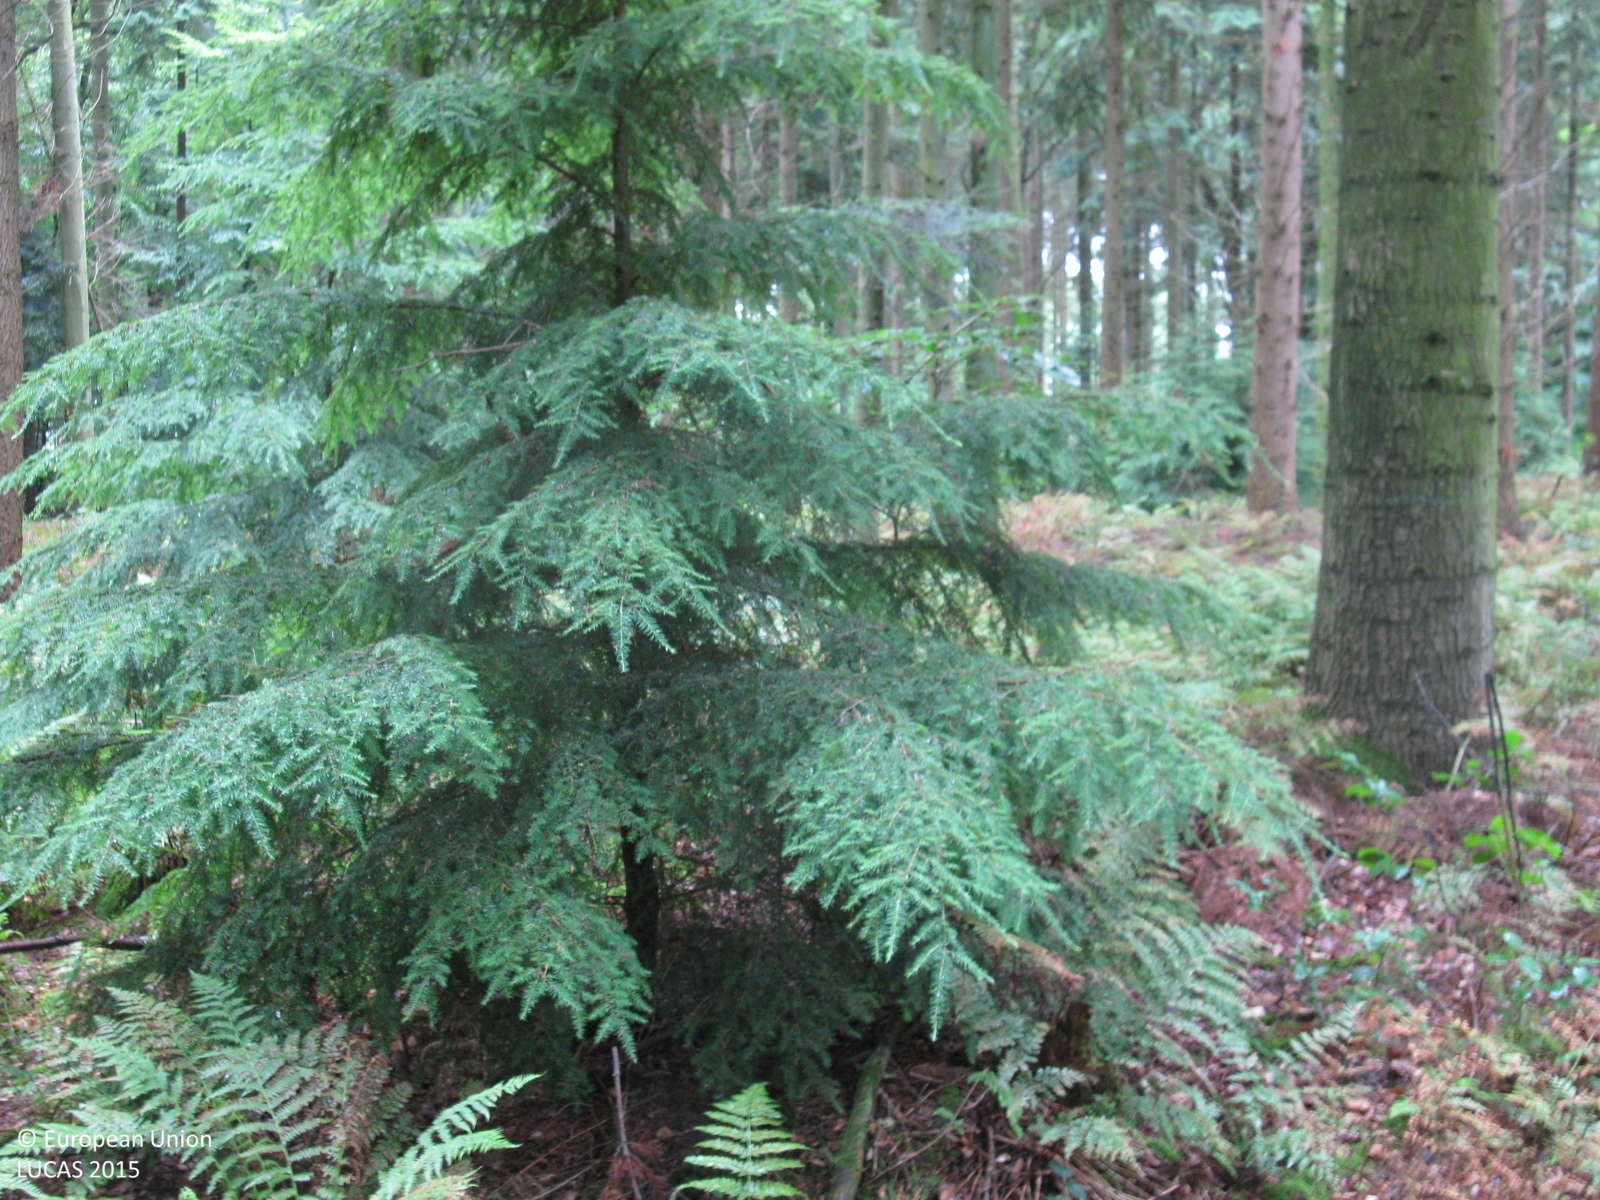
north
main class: Woodland
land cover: Other coniferous woodland
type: hemiboreal forest and nemoral coniferous forest and mixed broadleaved-coniferous forest
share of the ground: > 75 %
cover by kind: coniferous forest trees 100 %
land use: Forestry
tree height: > 5 m
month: July
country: DE
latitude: 52.9263
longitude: 8.5874
